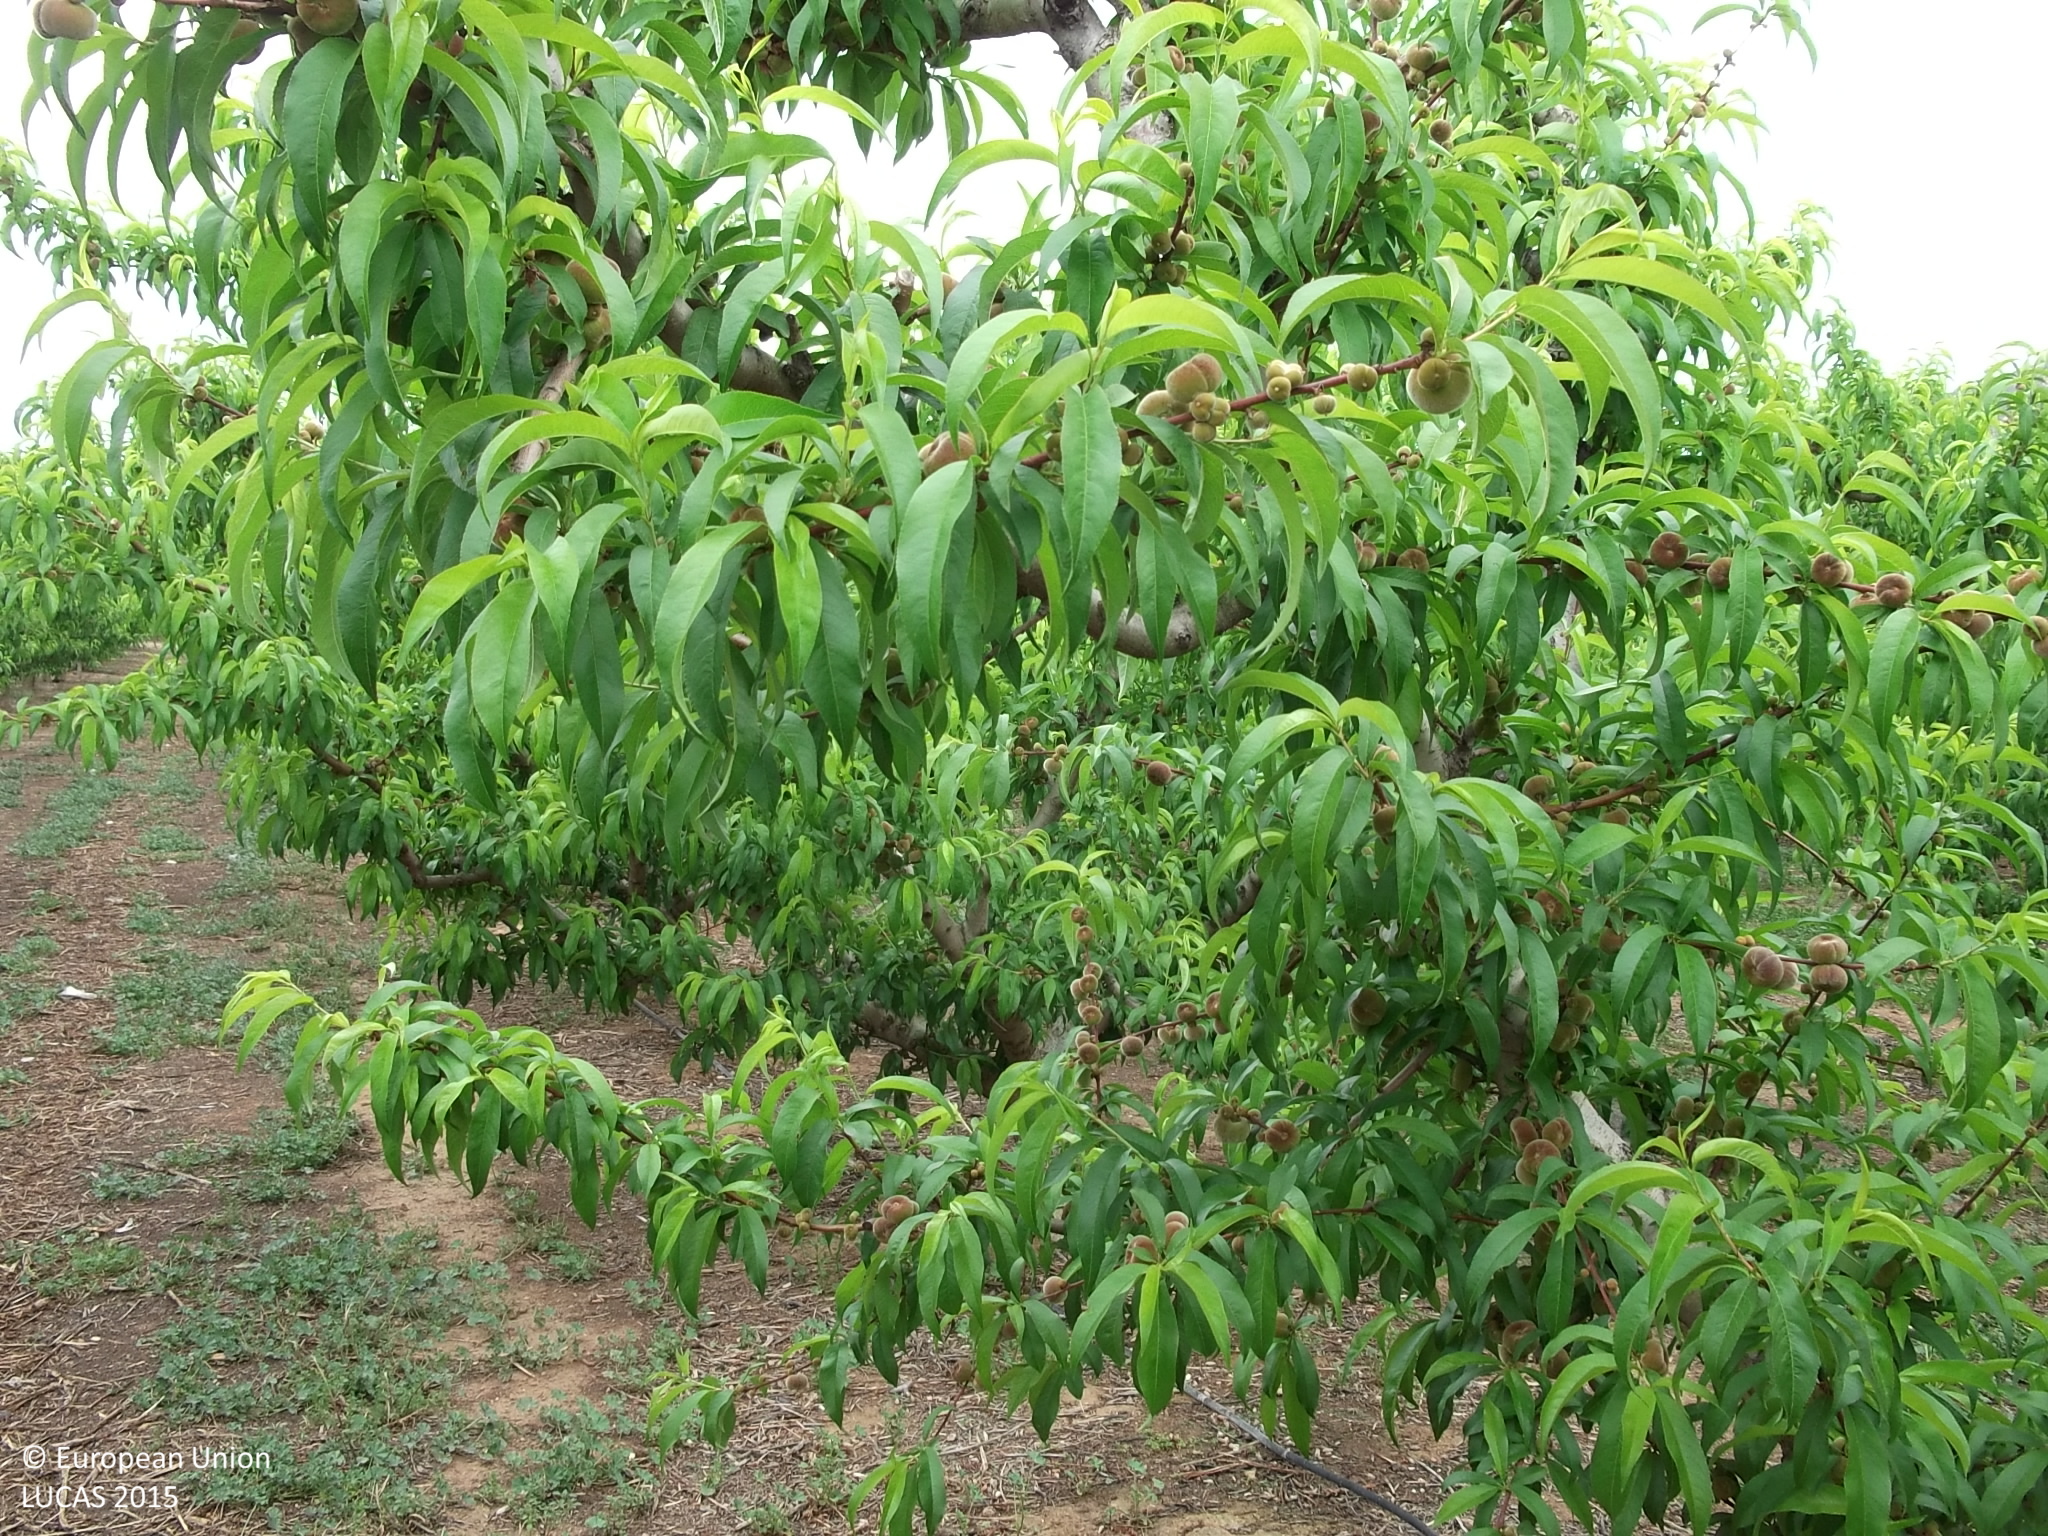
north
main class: Cropland
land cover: Other fruit trees and berries
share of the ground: 25 - 50 %
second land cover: Spontaneously vegetated surfaces
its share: 50 - 75 %
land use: Agriculture (excluding fallow land and kitchen gardens)
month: April
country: ES
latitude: 38.2204
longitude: -1.3300
